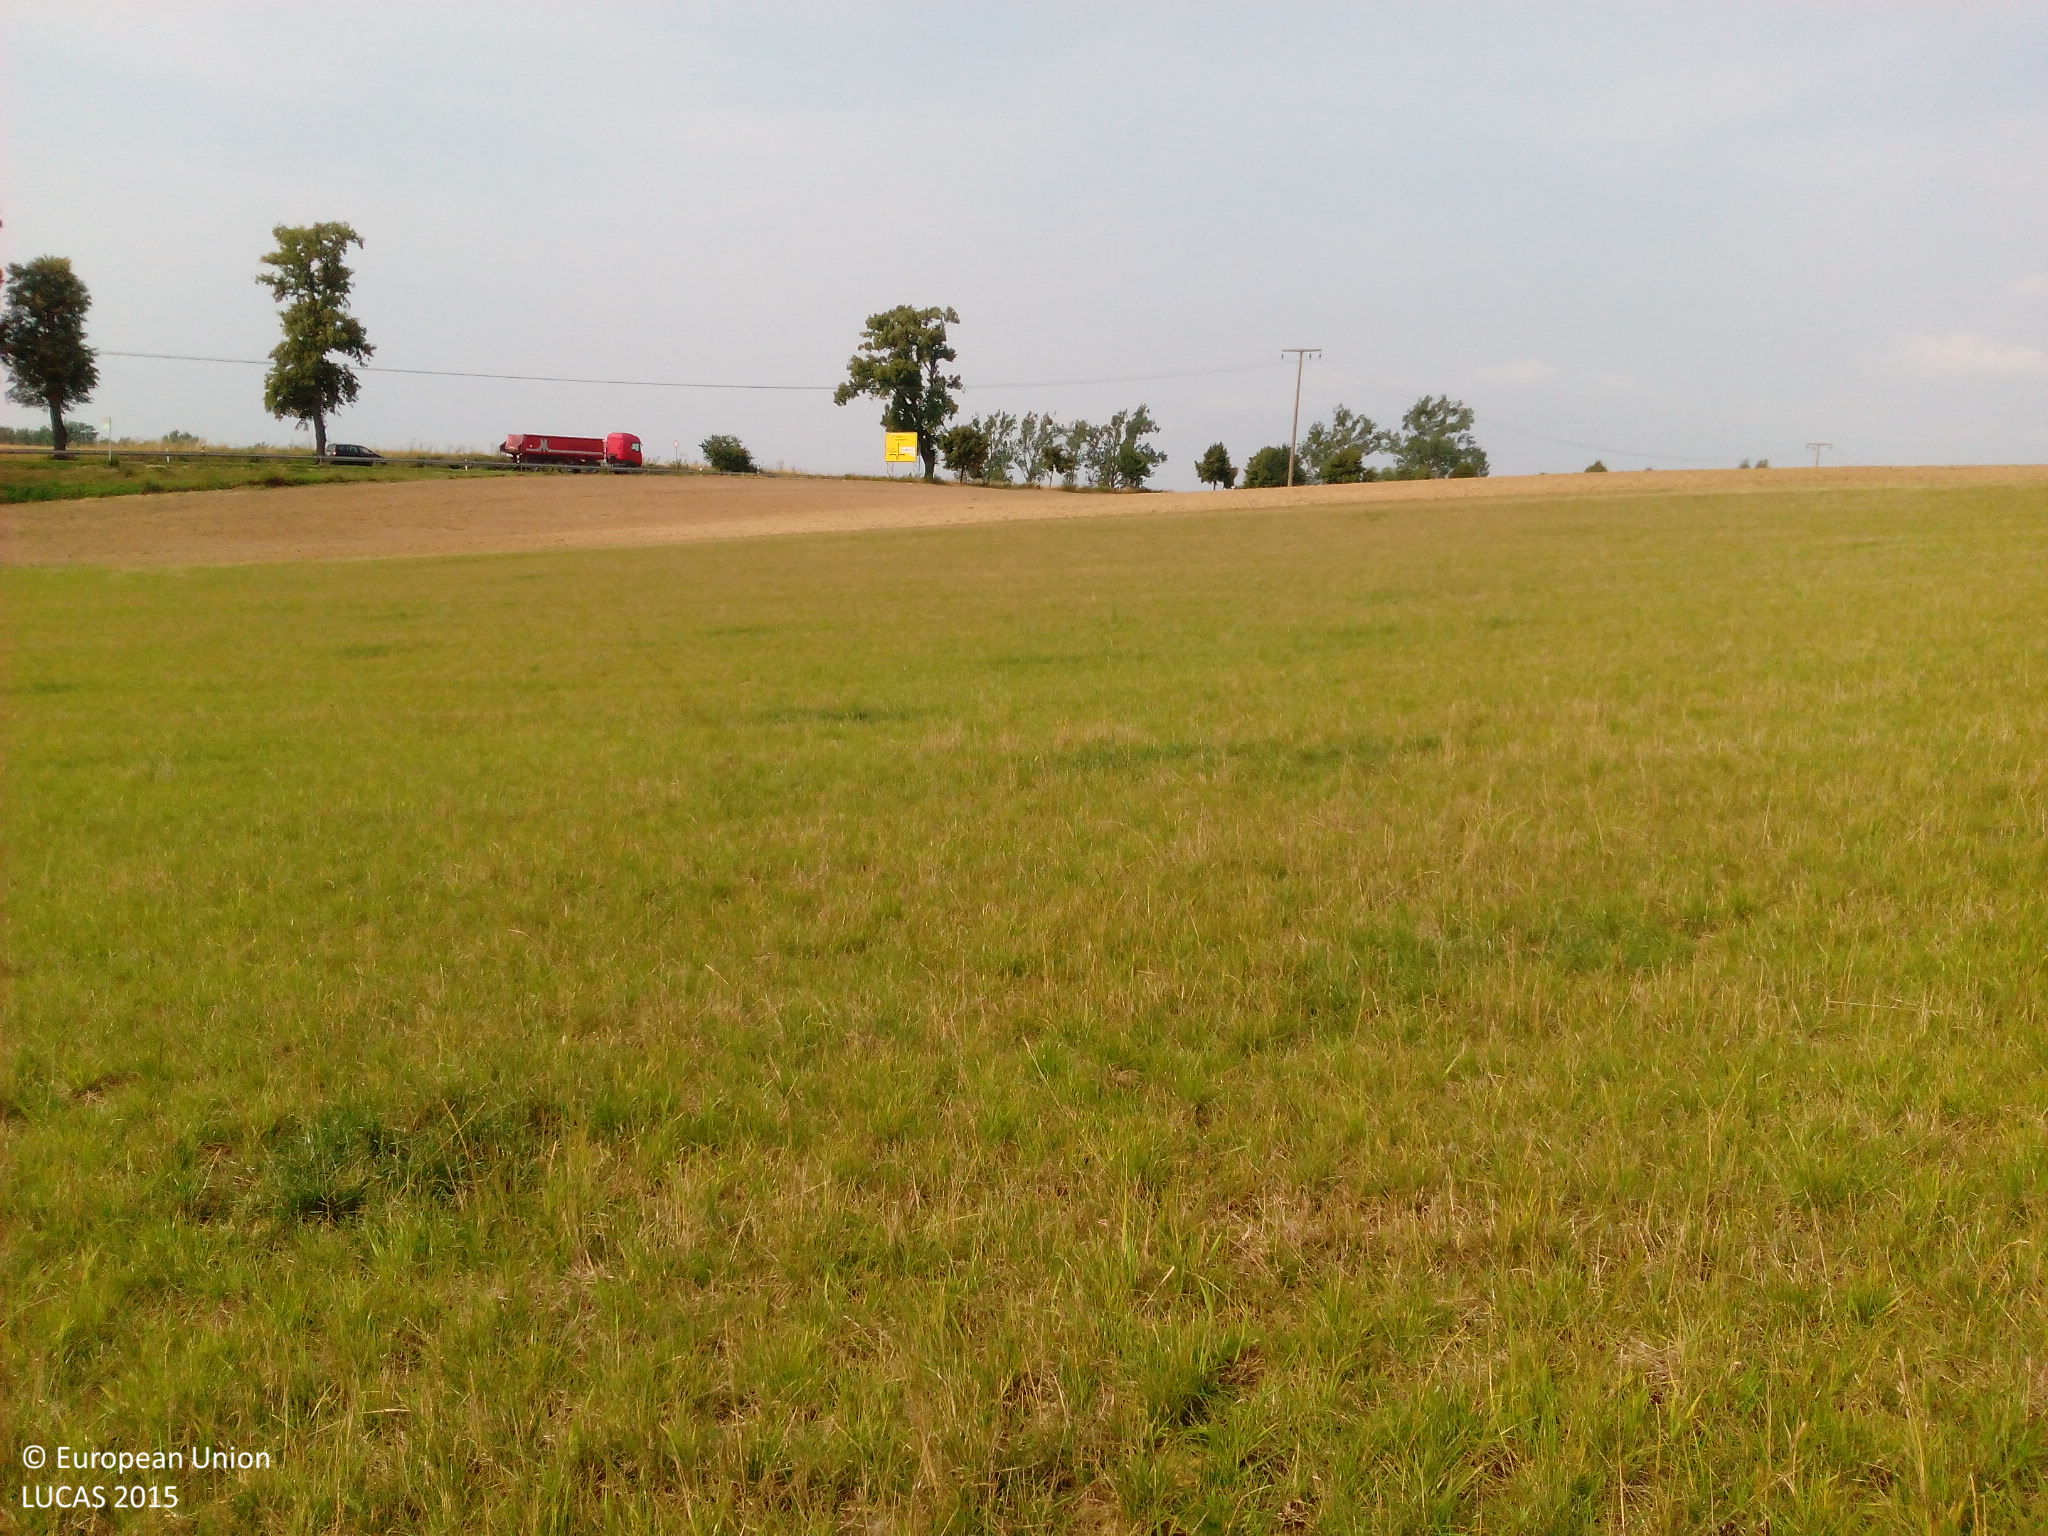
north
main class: Cropland
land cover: Temporary grasslands
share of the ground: > 75 %
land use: Agriculture (excluding fallow land and kitchen gardens)
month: August
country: DE
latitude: 53.4674
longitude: 13.2082
